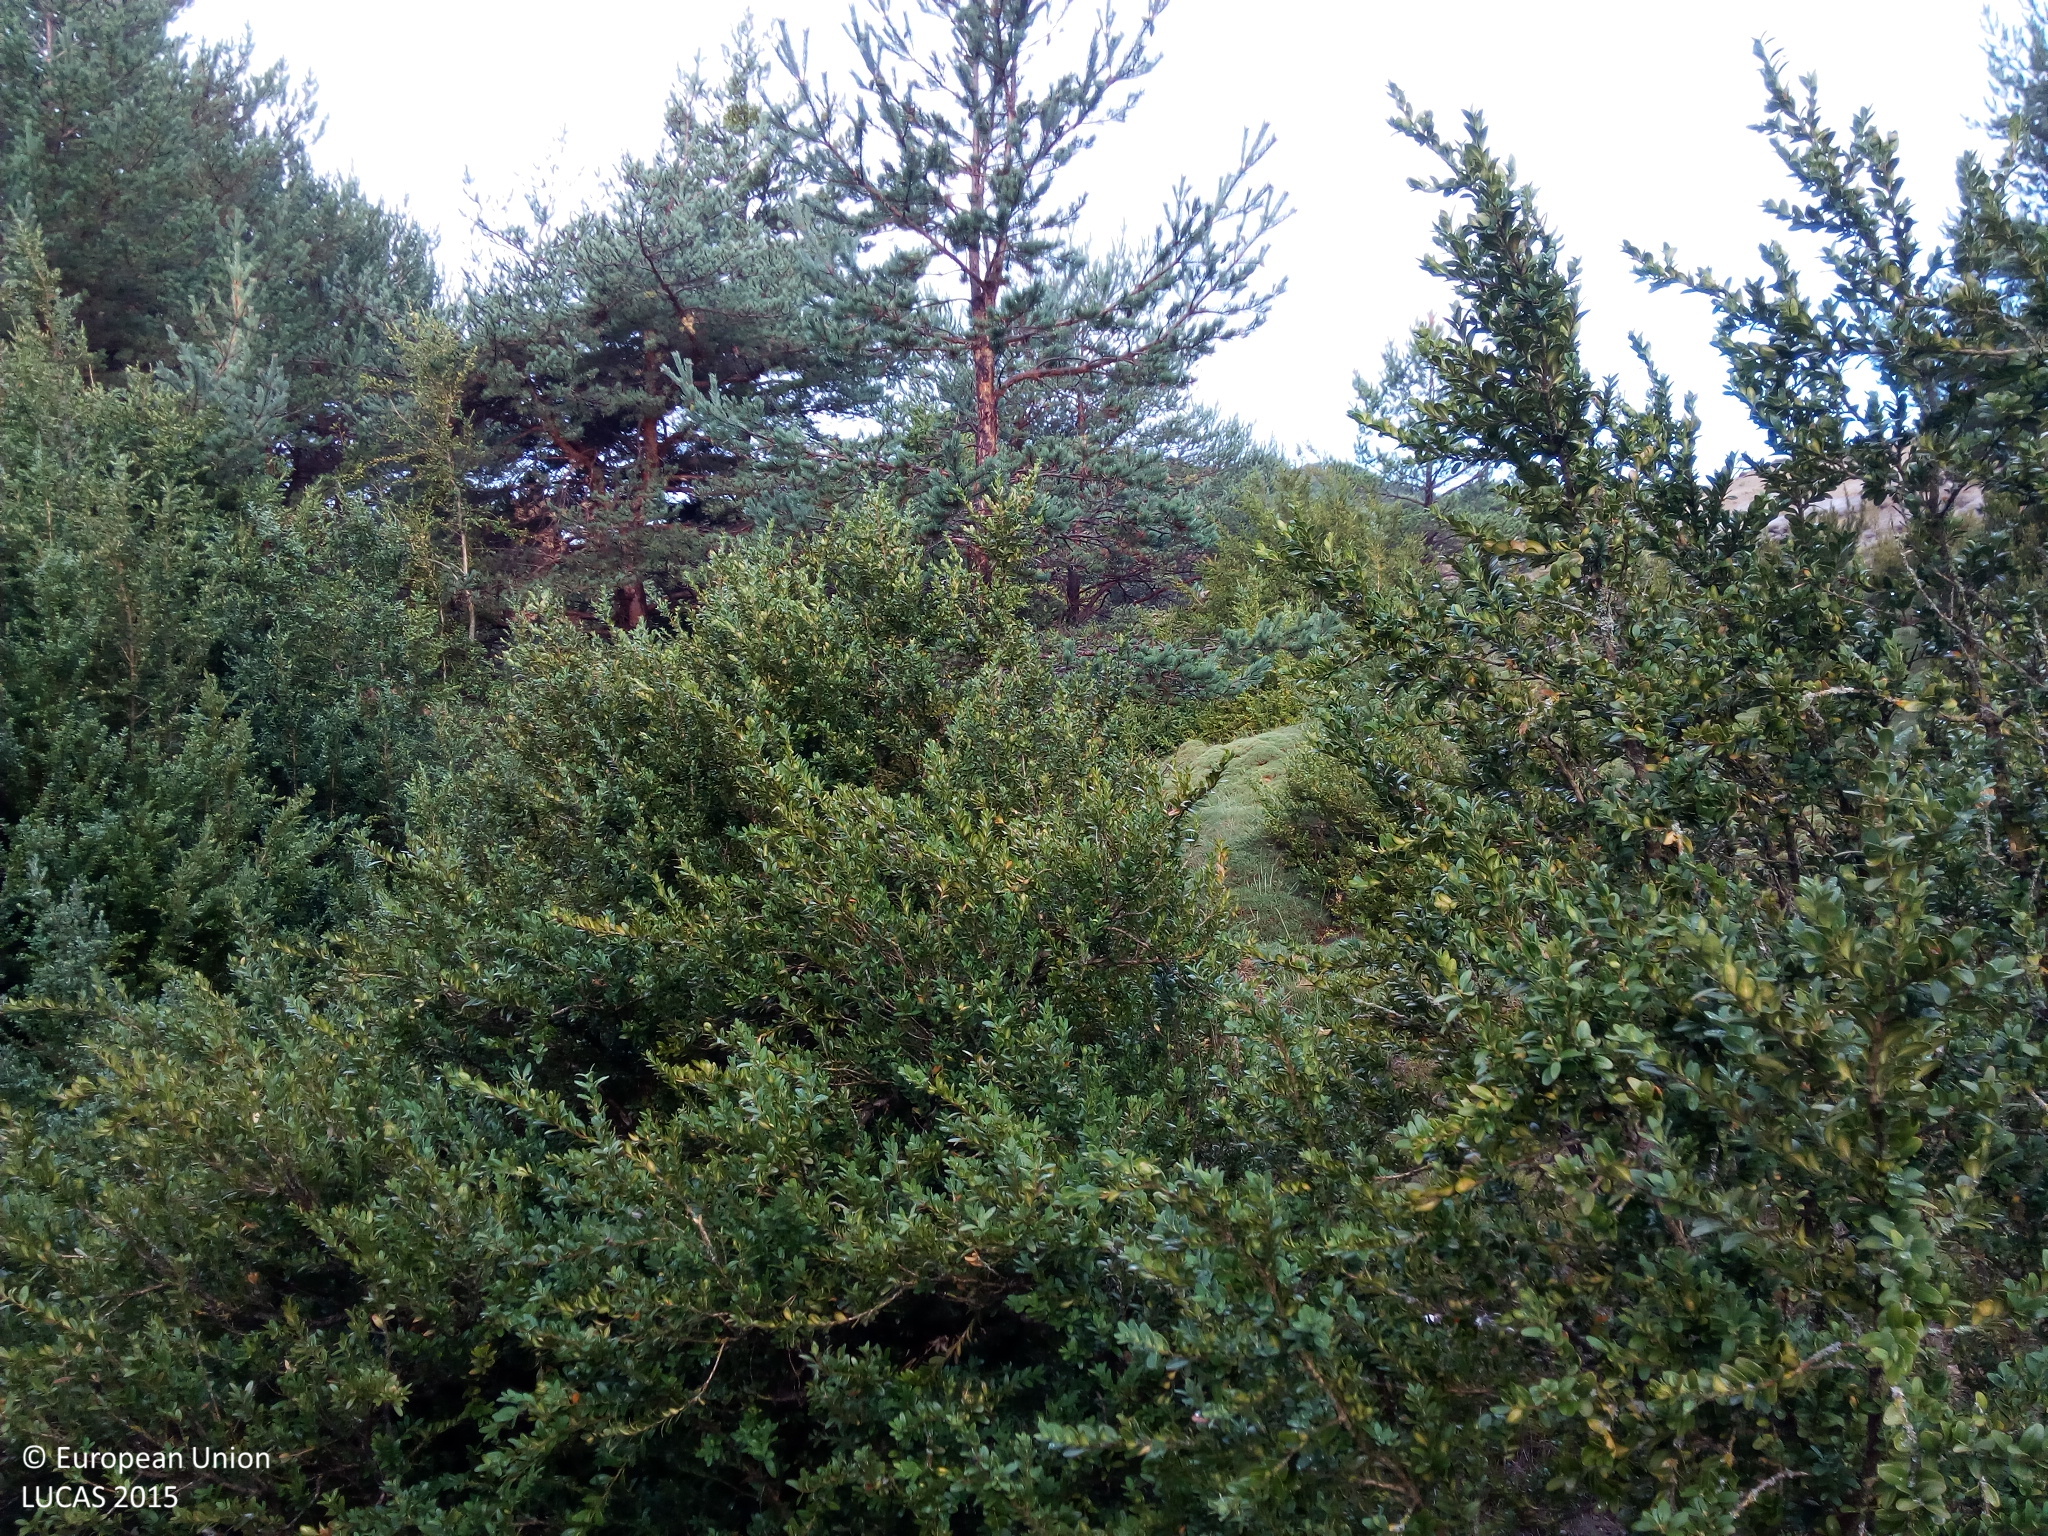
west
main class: Woodland
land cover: Pine dominated coniferous woodland
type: coniferous forest of the mediterranean region
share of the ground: > 75 %
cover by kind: coniferous forest trees 50 %, shrubs 40 %, herbaceous plants 10 %
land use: Agriculture (excluding fallow land and kitchen gardens)
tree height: > 5 m
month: September
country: ES
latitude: 42.4103
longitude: -0.0226
